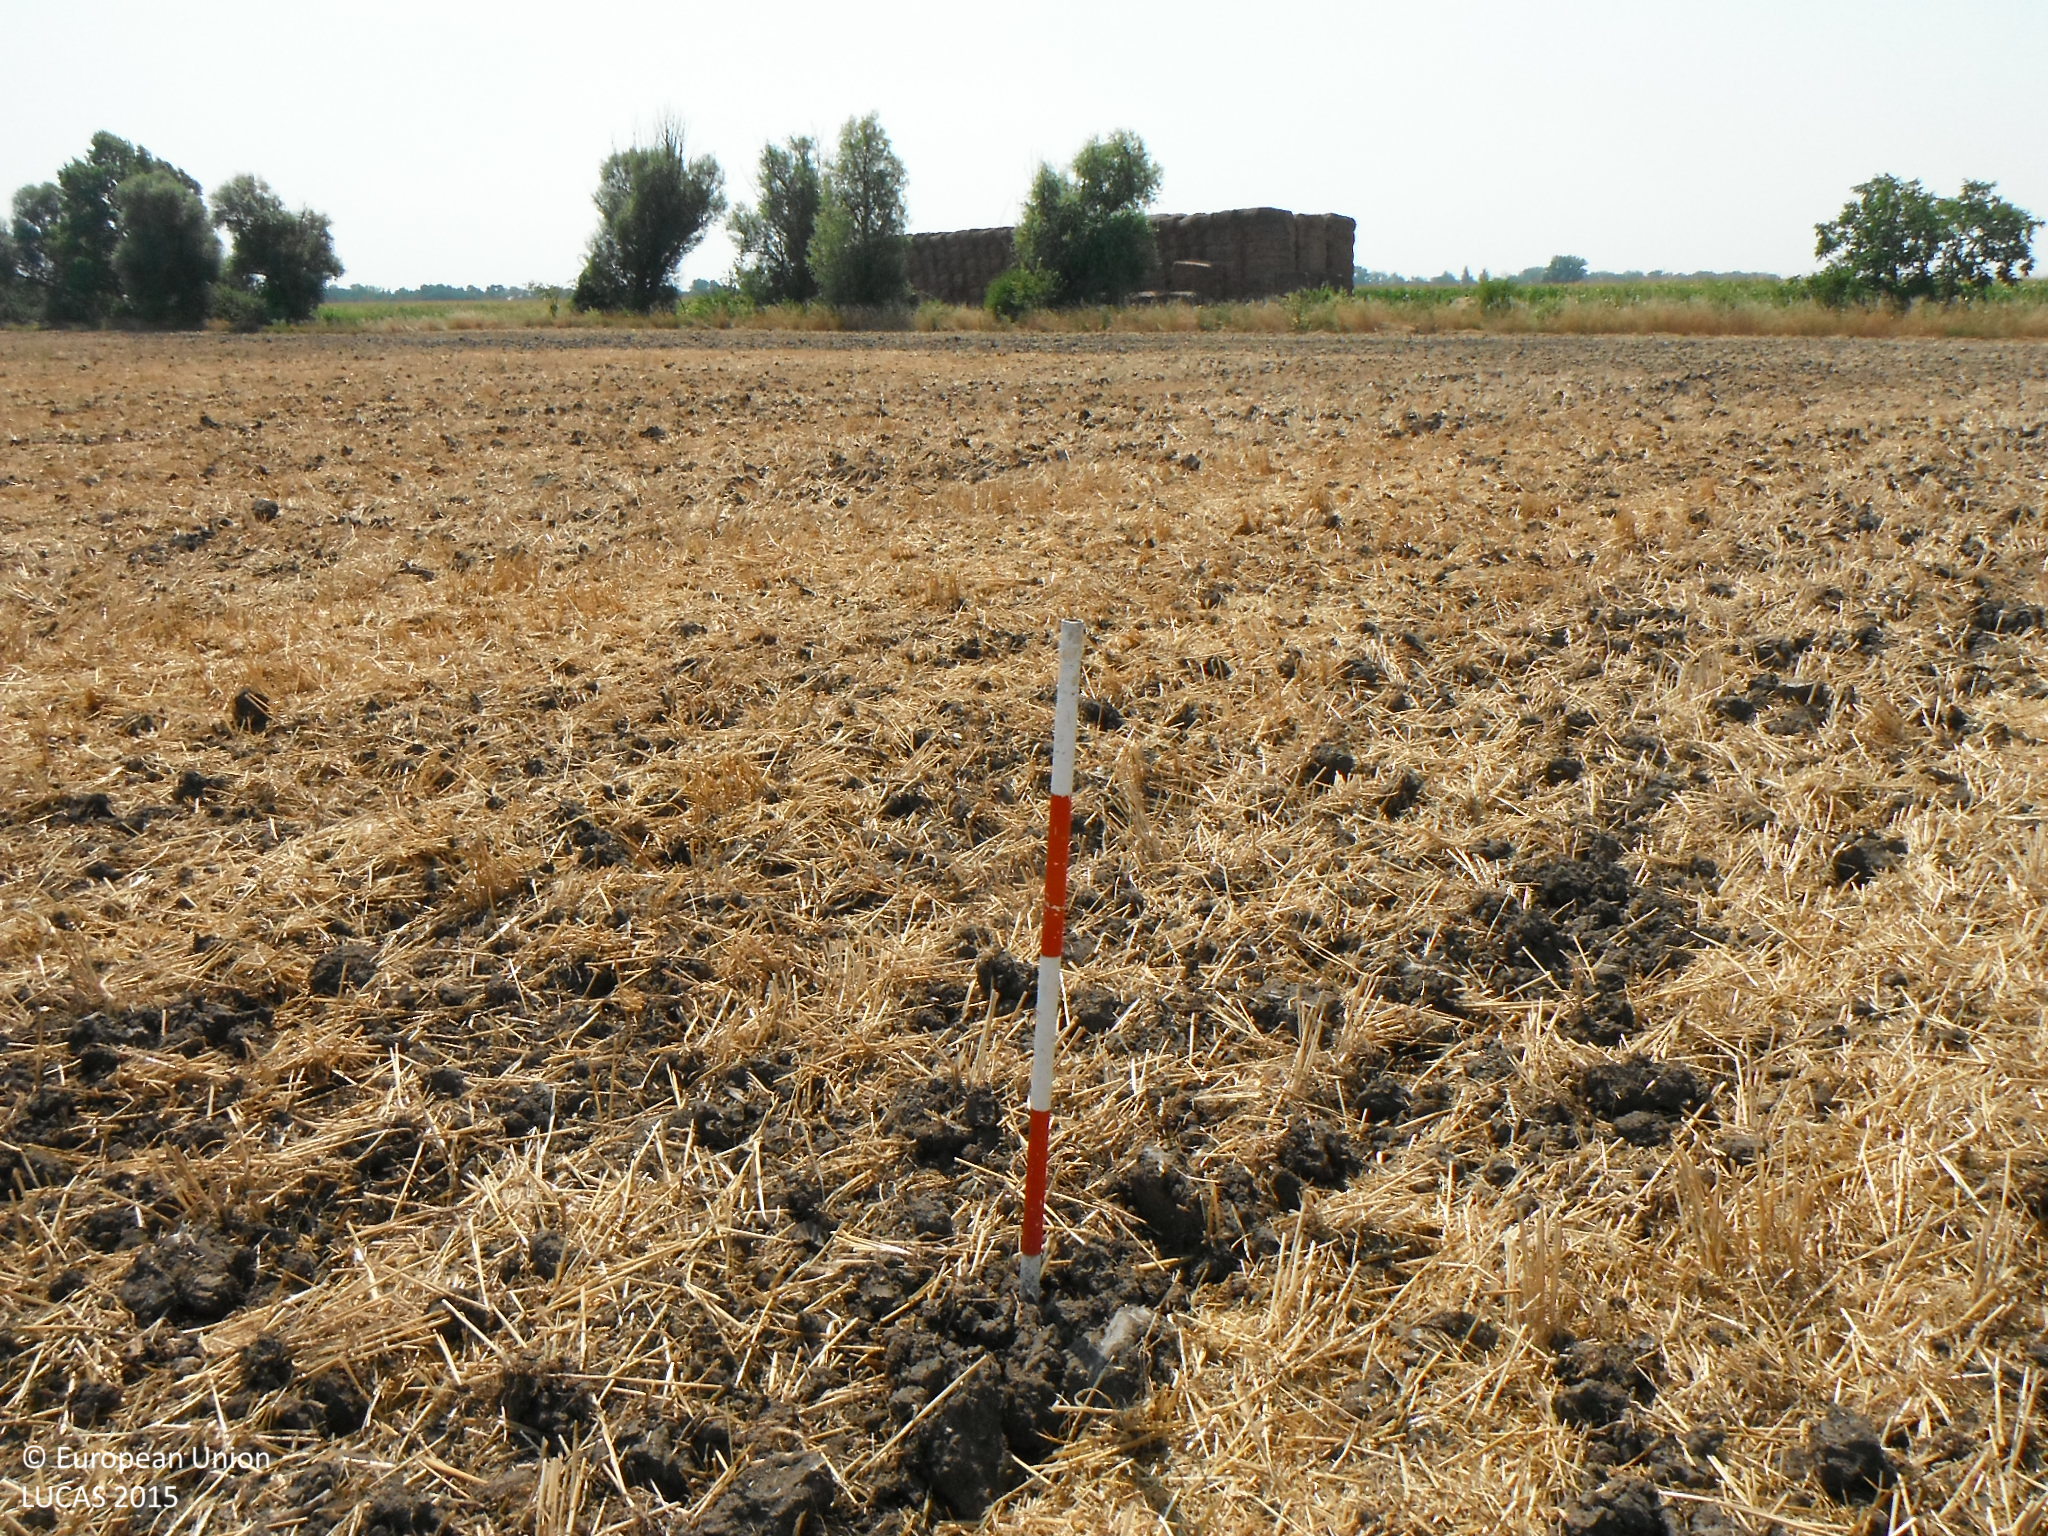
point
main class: Cropland
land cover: Common wheat
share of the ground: > 75 %
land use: Agriculture (excluding fallow land and kitchen gardens)
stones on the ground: < 10 %
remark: Harvested field
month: August
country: SK
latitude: 47.9880
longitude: 18.2275
